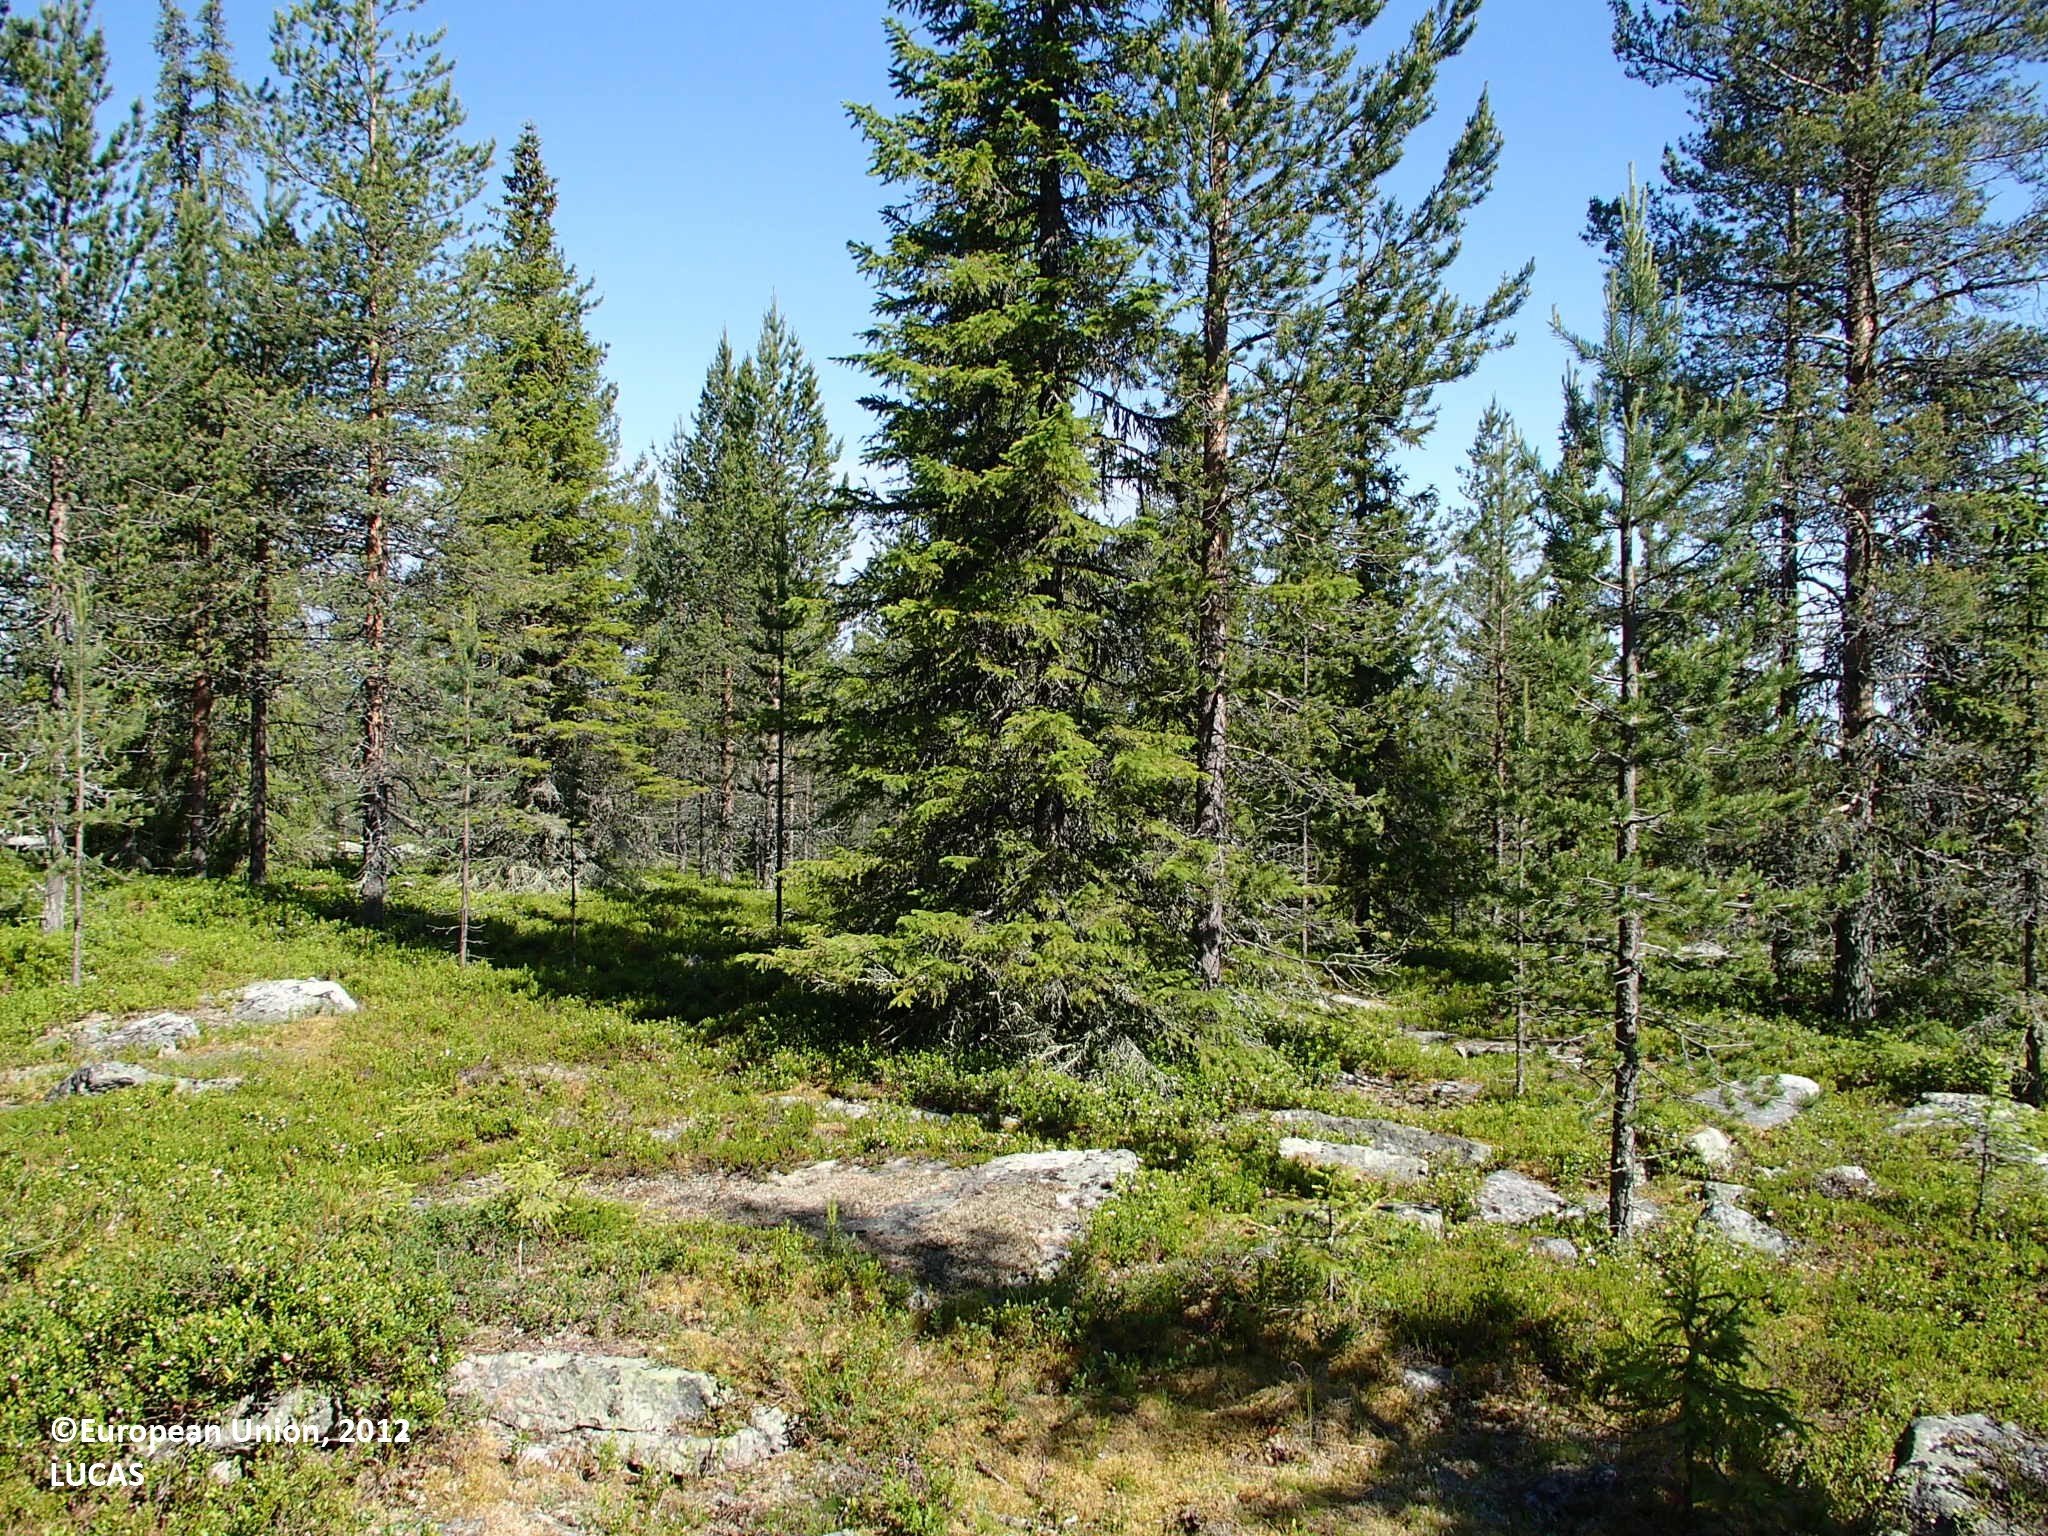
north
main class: Woodland
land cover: Other coniferous woodland
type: boreal forest
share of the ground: > 75 %
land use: Forestry
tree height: > 5 m
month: July
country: FI
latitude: 67.3405
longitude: 26.0431
